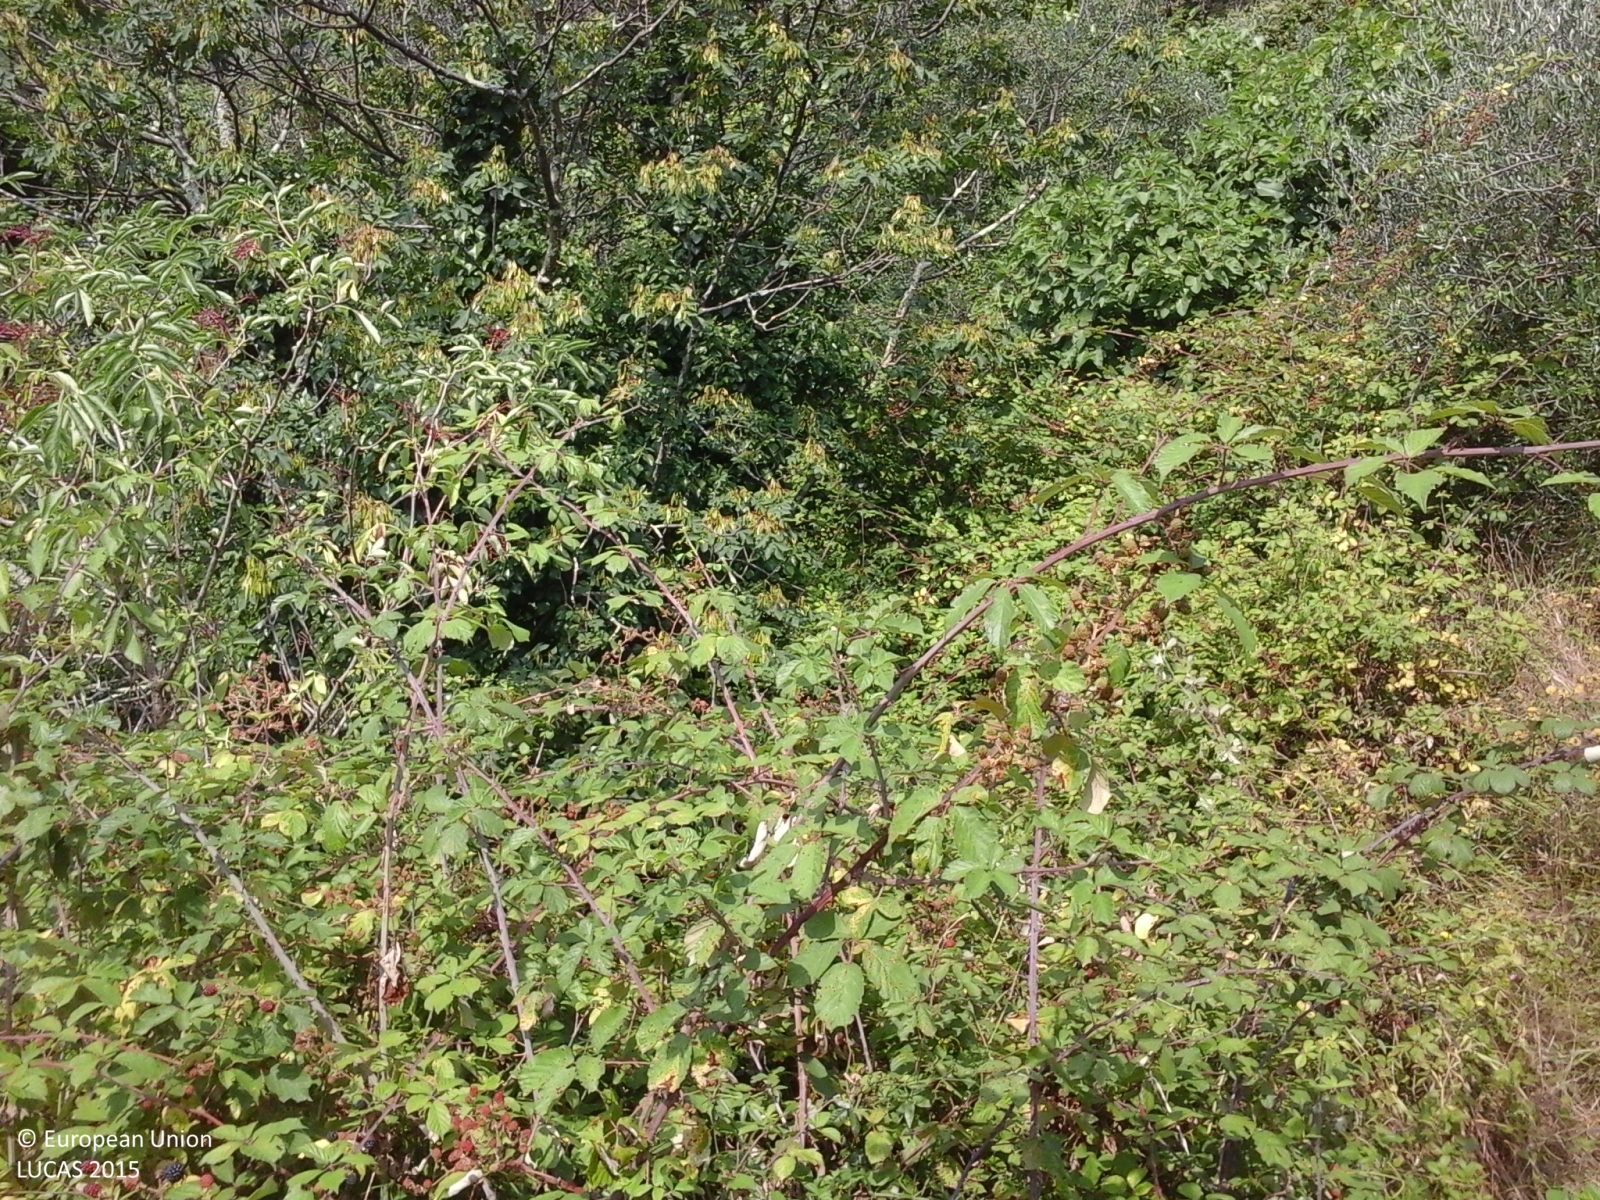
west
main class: Cropland
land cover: Olive groves
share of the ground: > 75 %
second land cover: Grassland without tree/shrub cover
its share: > 75 %
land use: Agriculture (excluding fallow land and kitchen gardens)
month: August
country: IT
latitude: 43.9533
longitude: 10.2859
